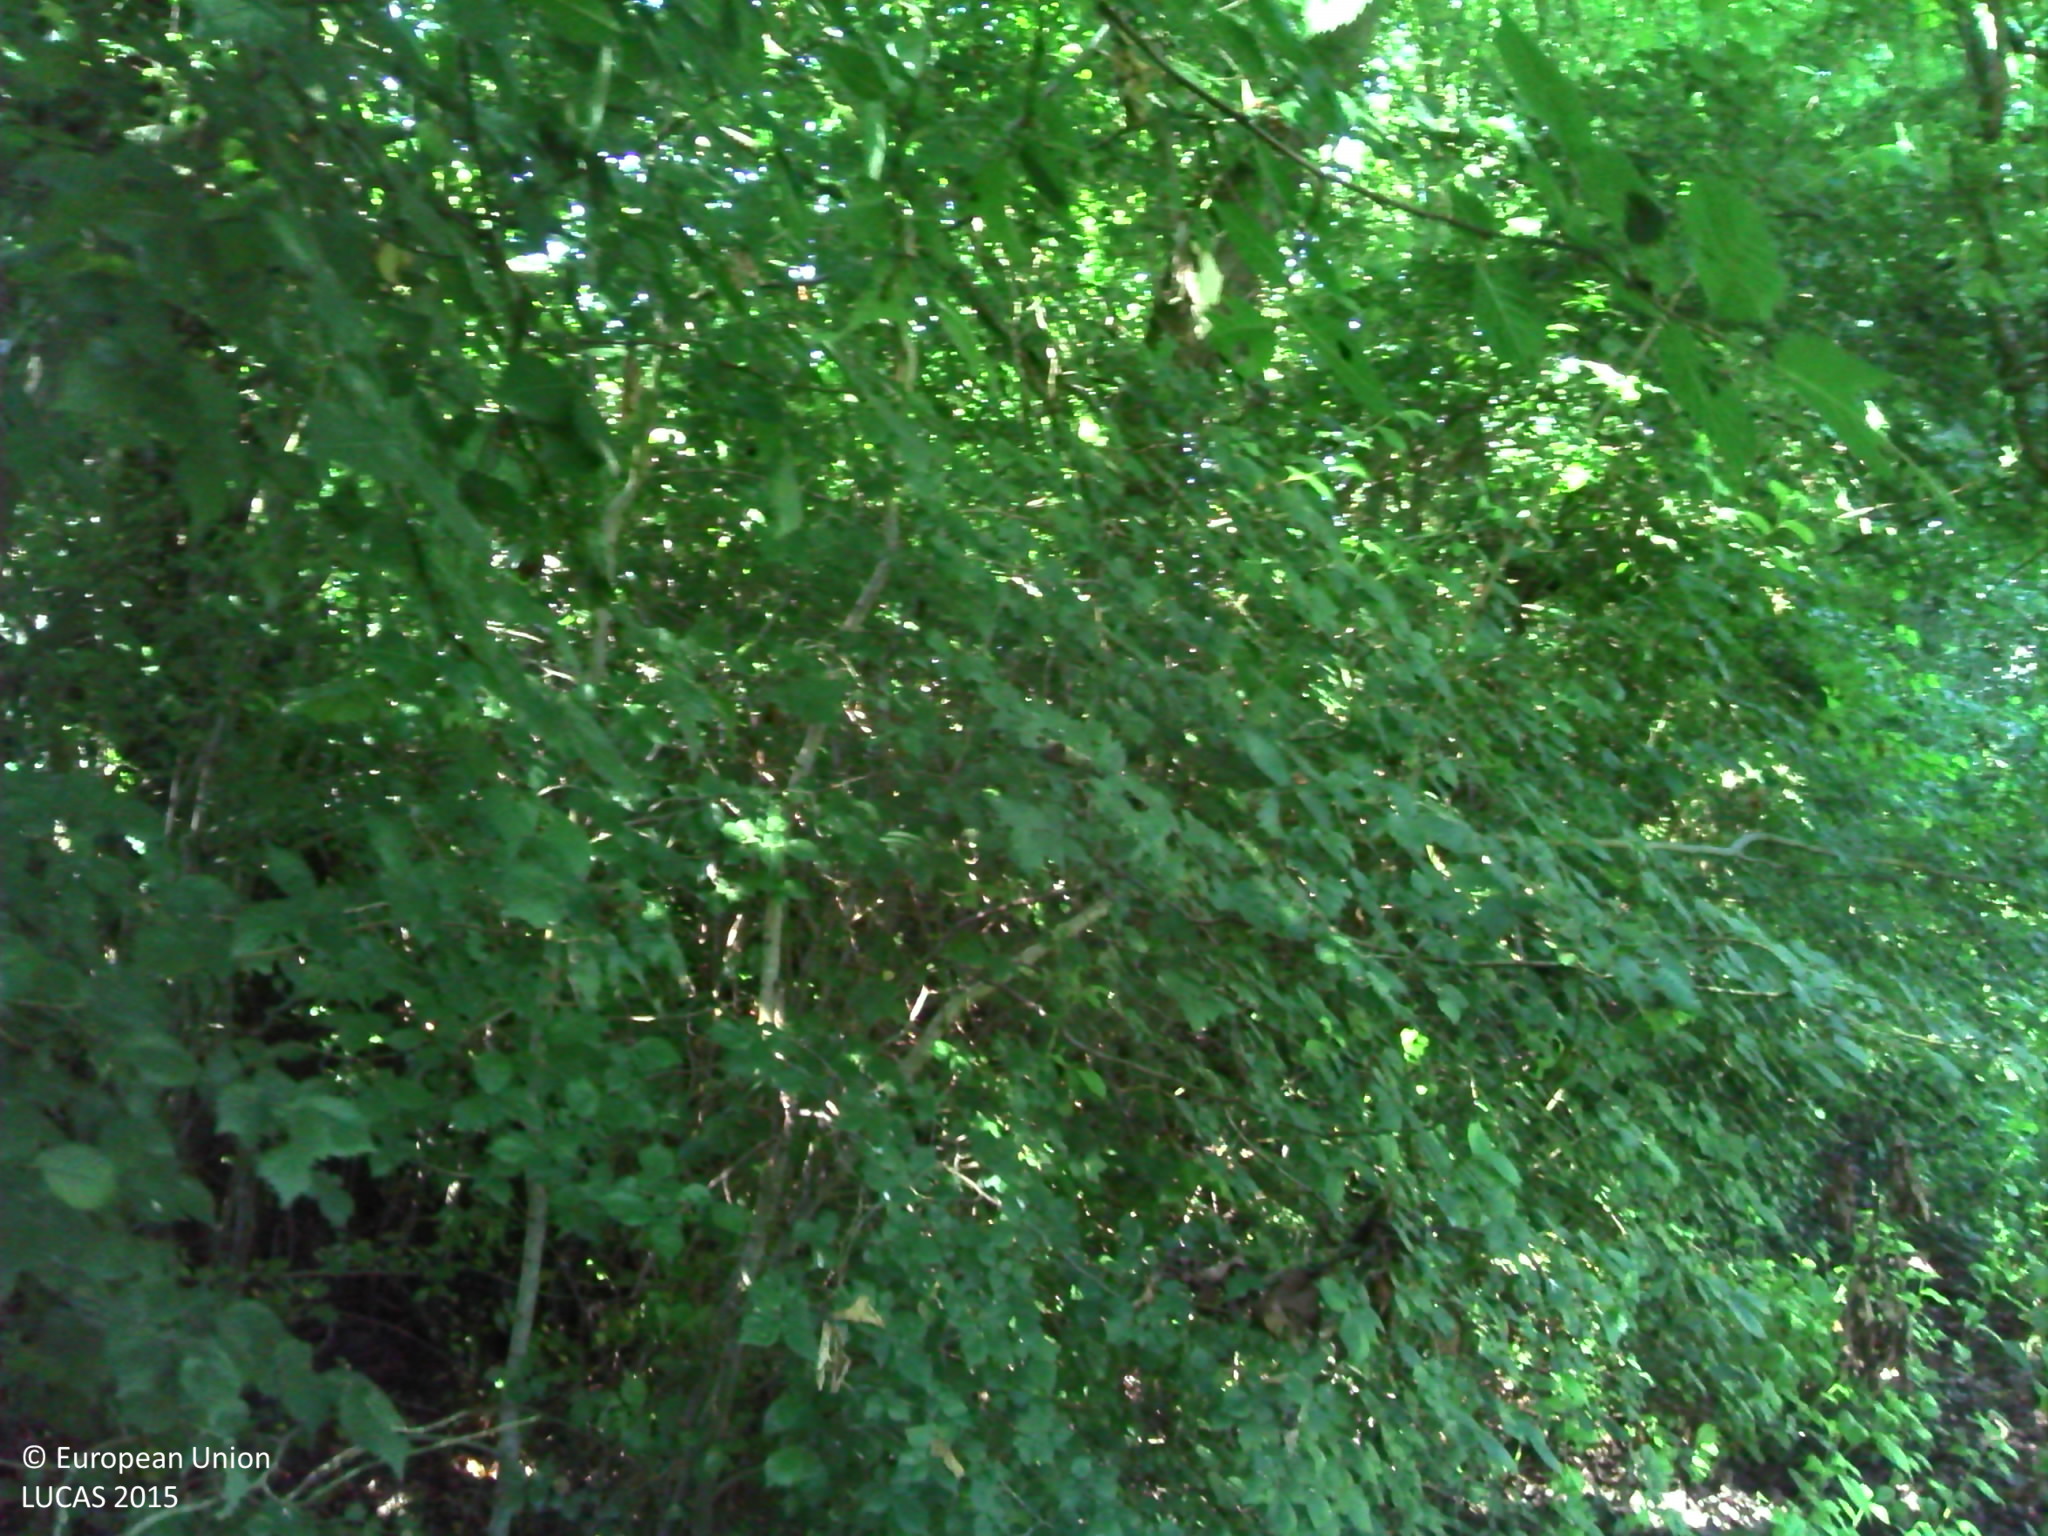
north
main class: Woodland
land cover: Broadleaved woodland
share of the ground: > 75 %
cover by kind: broadleaved forest trees 90 %, herbaceous plants 10 %
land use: Sport
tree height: > 5 m
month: June
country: FR
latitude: 48.0370
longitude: -1.6760
